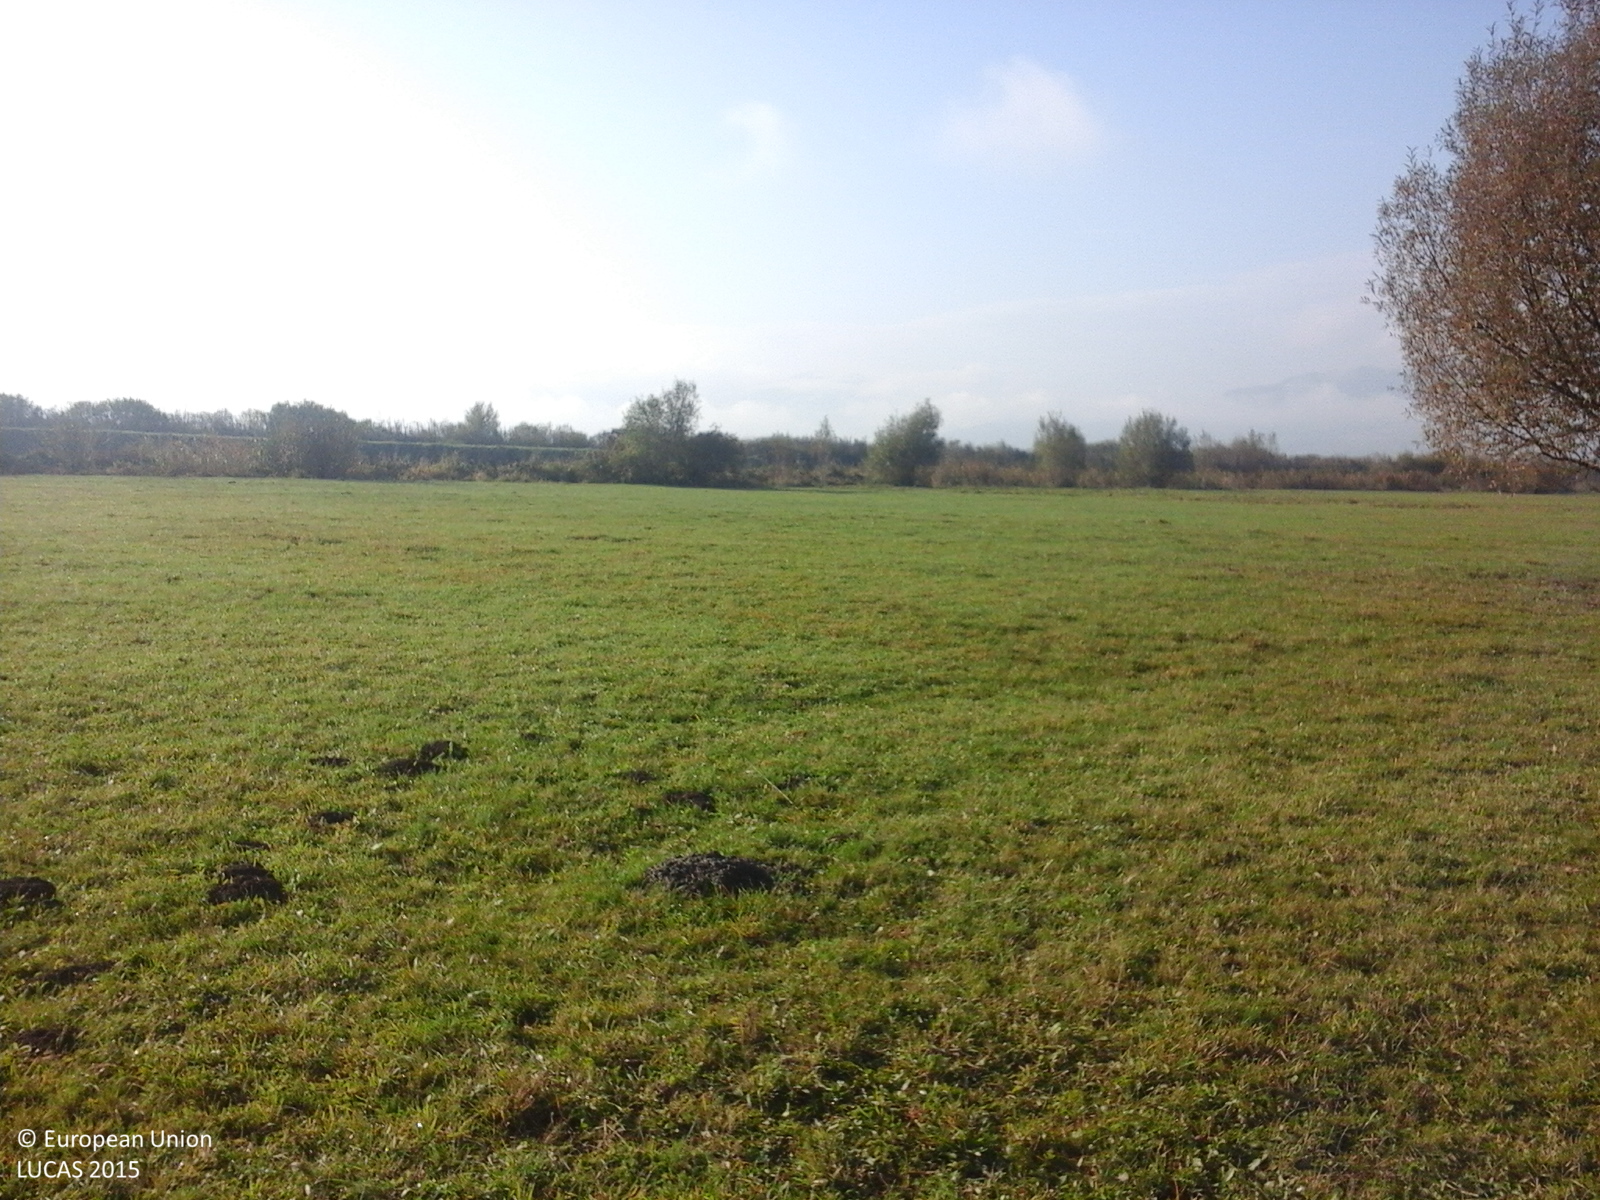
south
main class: Grassland
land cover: Grassland without tree/shrub cover
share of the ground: > 75 %
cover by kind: herbaceous plants 100 %
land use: Agriculture (excluding fallow land and kitchen gardens)
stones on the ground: < 10 %
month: October
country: RO
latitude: 46.2348
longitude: 25.8977
